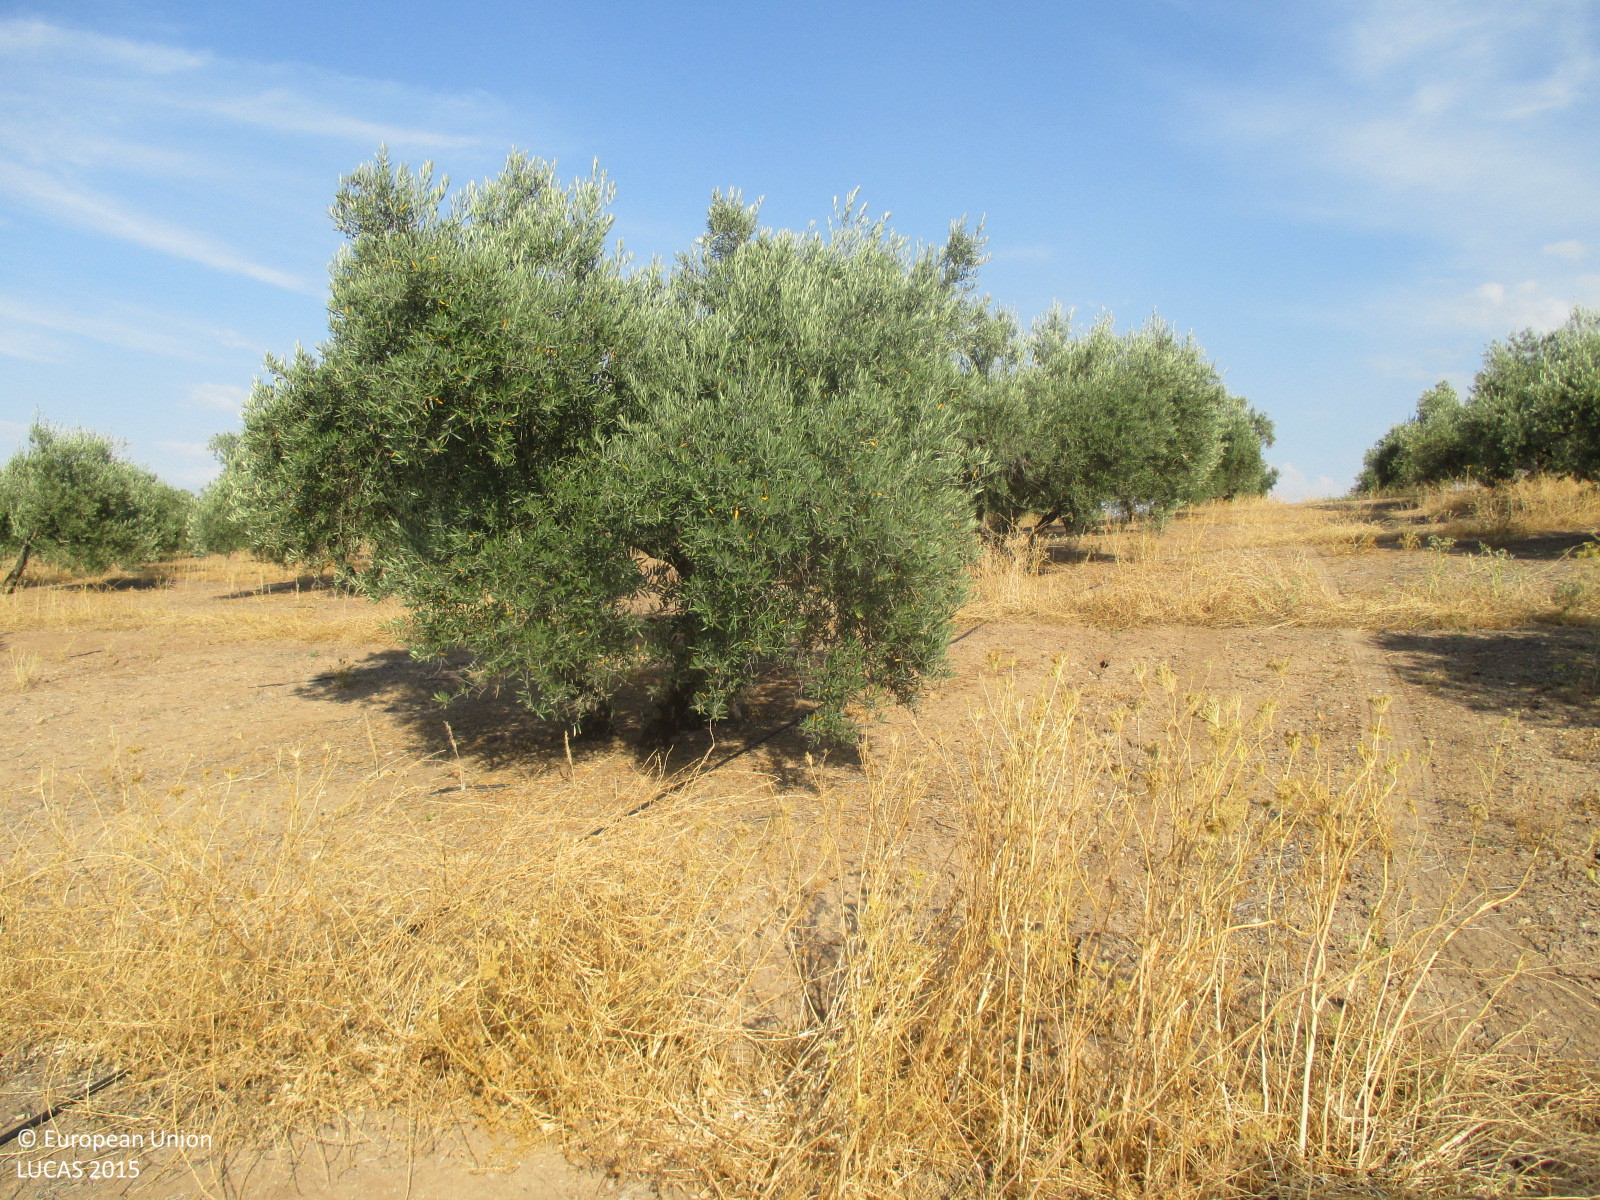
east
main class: Cropland
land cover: Olive groves
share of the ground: 25 - 50 %
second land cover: Other bare soil
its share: > 75 %
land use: Agriculture (excluding fallow land and kitchen gardens)
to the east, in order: Olive groves; Other bare soil
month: June
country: ES
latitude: 37.6237
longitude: -4.1308
